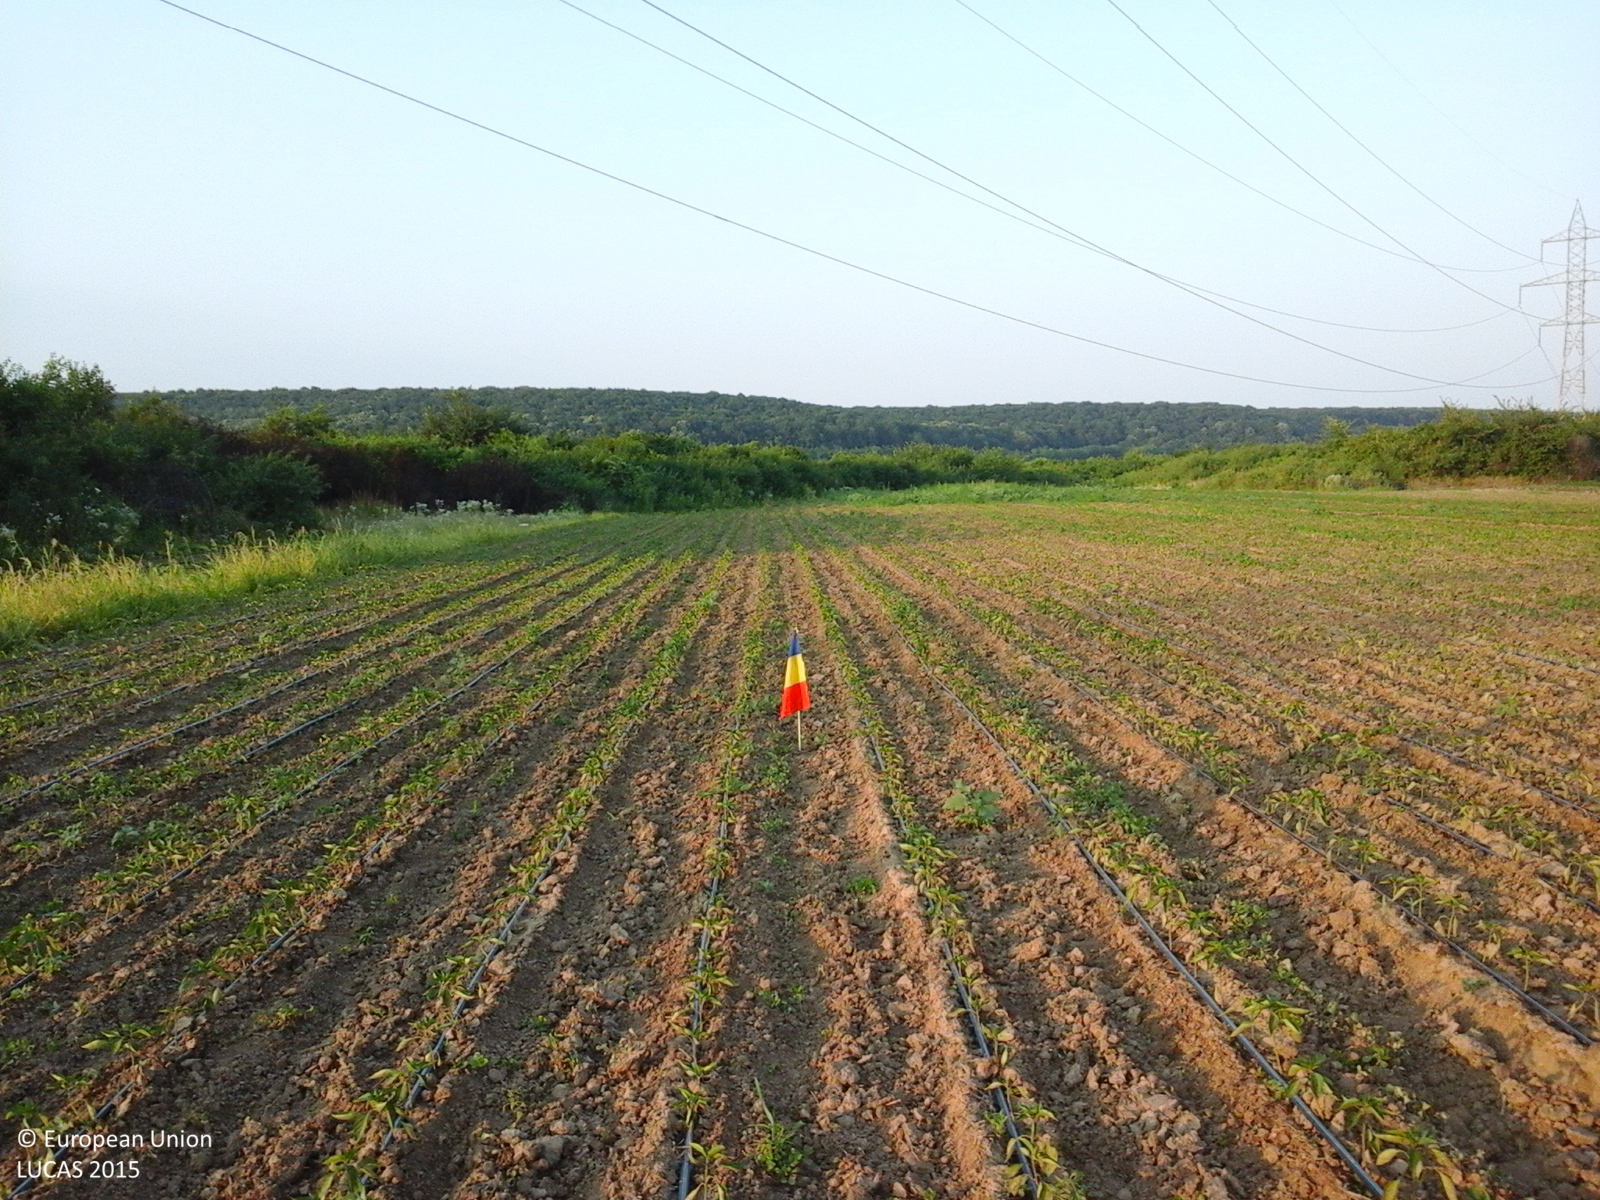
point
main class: Cropland
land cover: Other fresh vegetables
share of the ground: 10 - 25 %
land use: Agriculture (excluding fallow land and kitchen gardens)
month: July
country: RO
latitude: 44.8348
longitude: 25.6964
